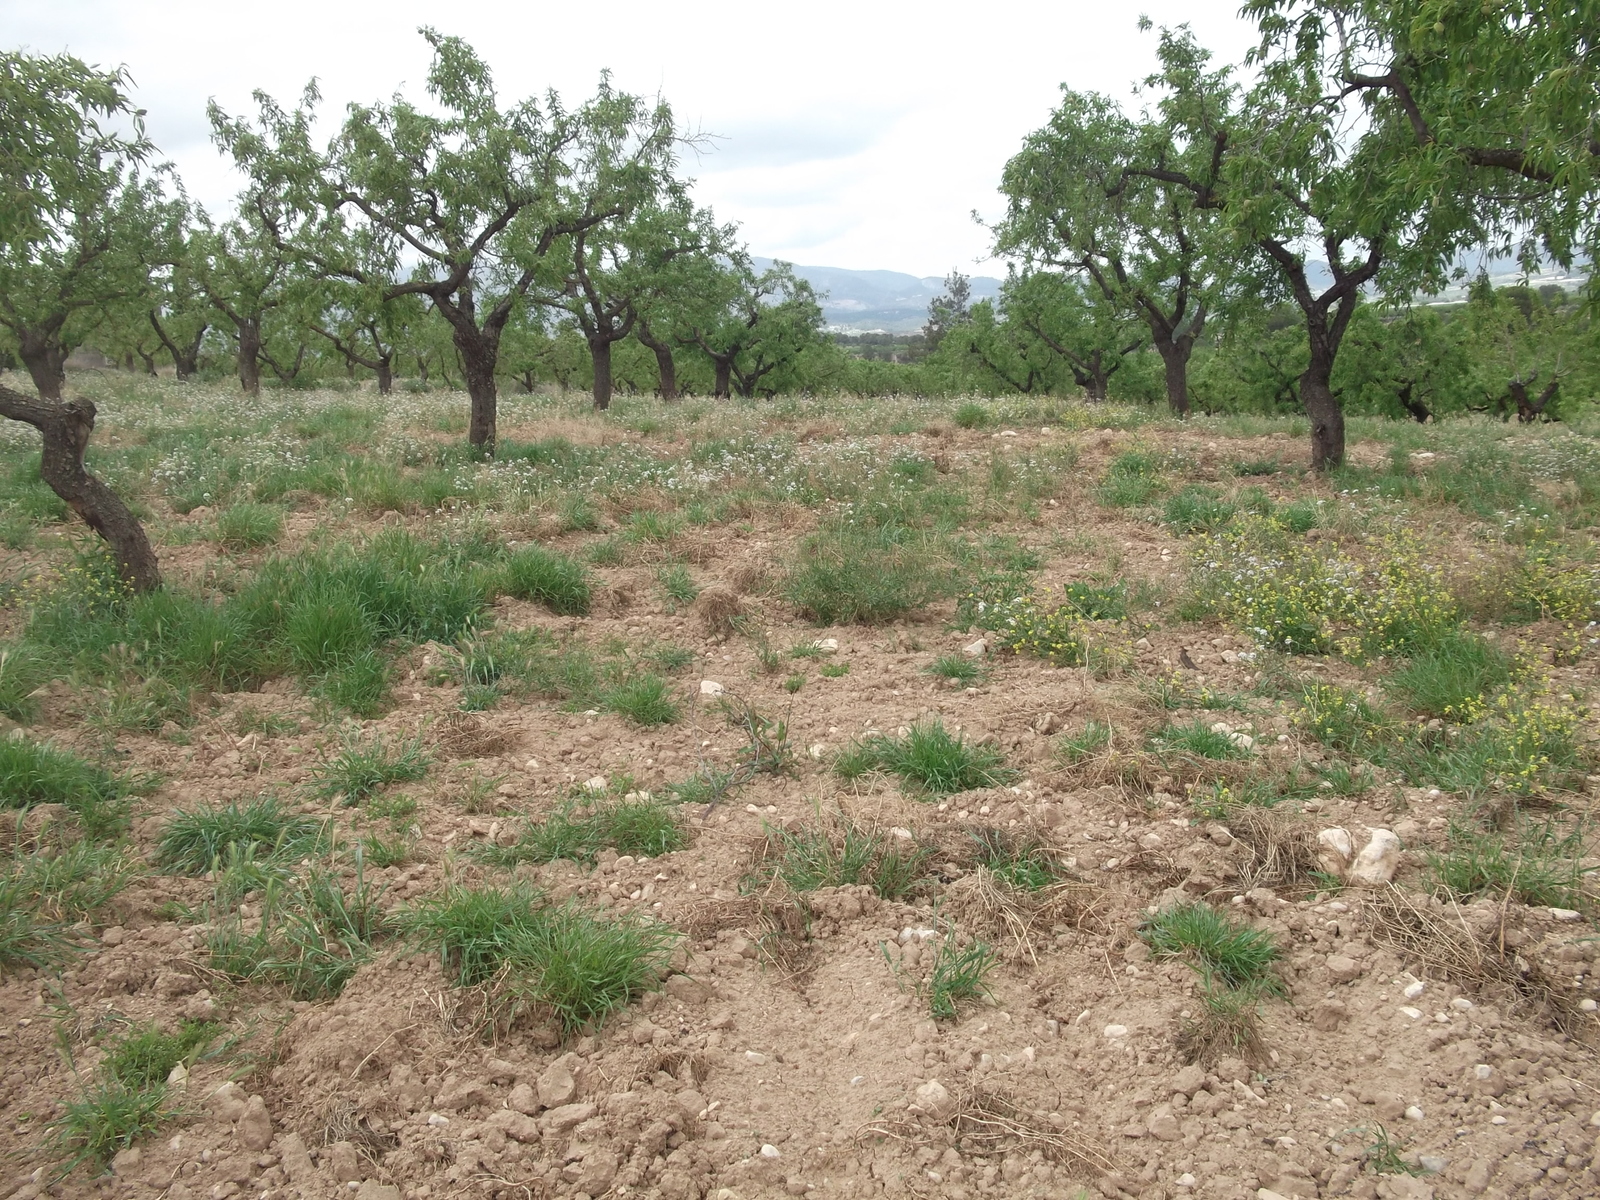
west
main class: Cropland
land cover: Nuts trees
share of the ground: 10 - 25 %
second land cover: Spontaneously vegetated surfaces
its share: > 75 %
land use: Agriculture (excluding fallow land and kitchen gardens)
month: April
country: ES
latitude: 37.9577
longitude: -1.5376
